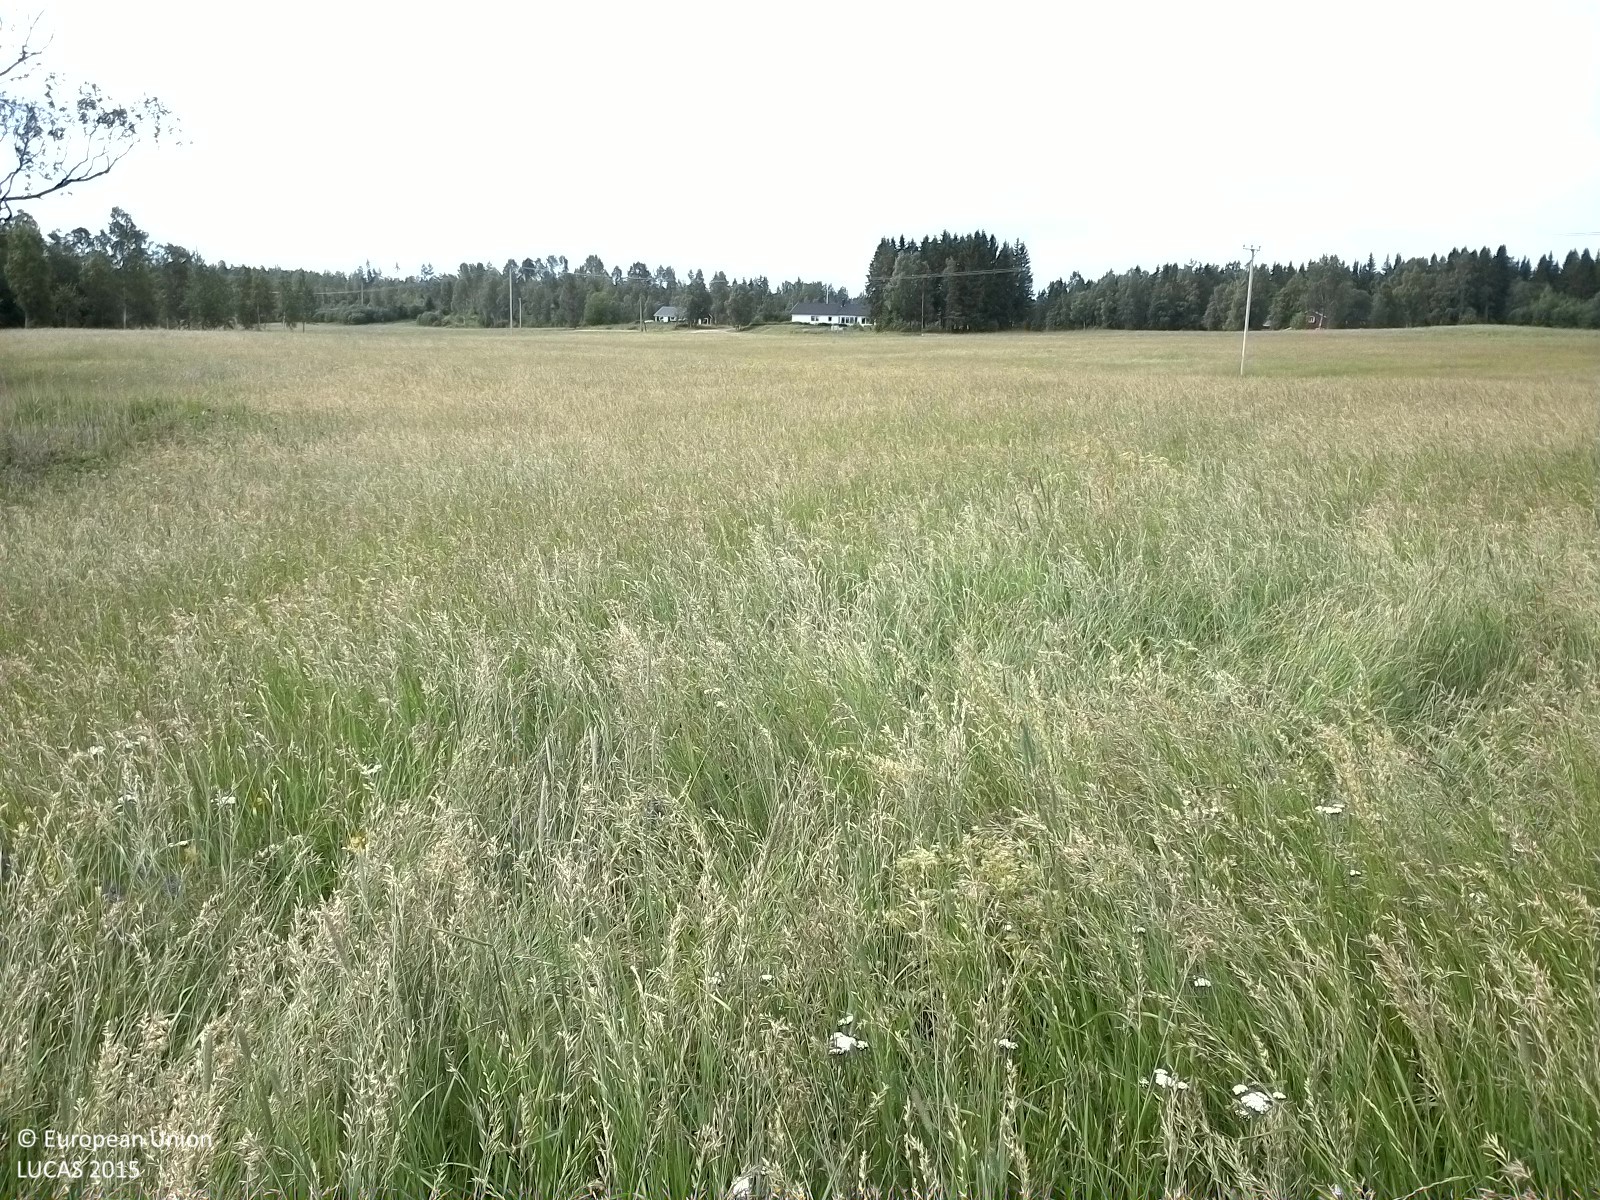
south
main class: Cropland
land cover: Other leguminous and mixtures for fodder
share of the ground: > 75 %
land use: Agriculture (excluding fallow land and kitchen gardens)
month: July
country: SE
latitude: 62.5103
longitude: 17.6121
